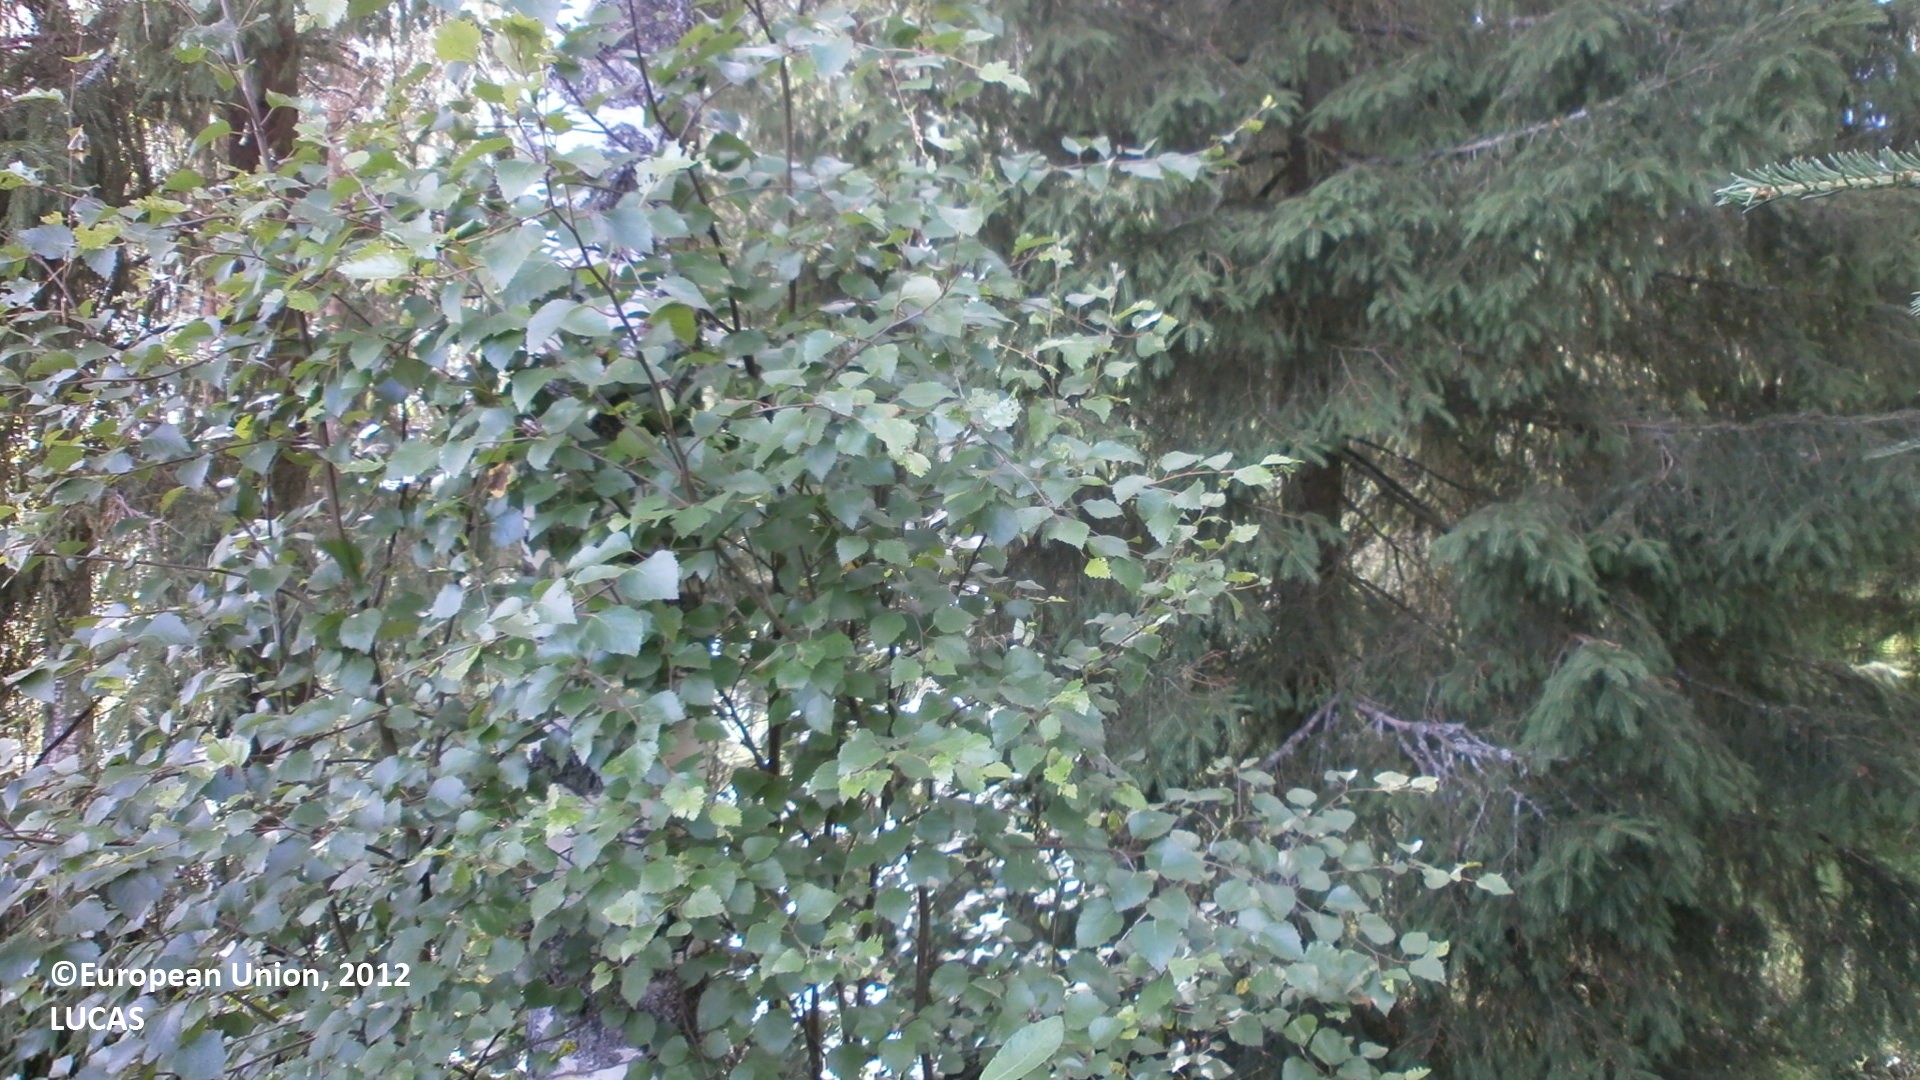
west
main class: Woodland
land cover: Spruce dominated mixed woodland
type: boreal forest
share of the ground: > 75 %
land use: Forestry
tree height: > 5 m
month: July
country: FI
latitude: 63.9780
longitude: 23.9779
